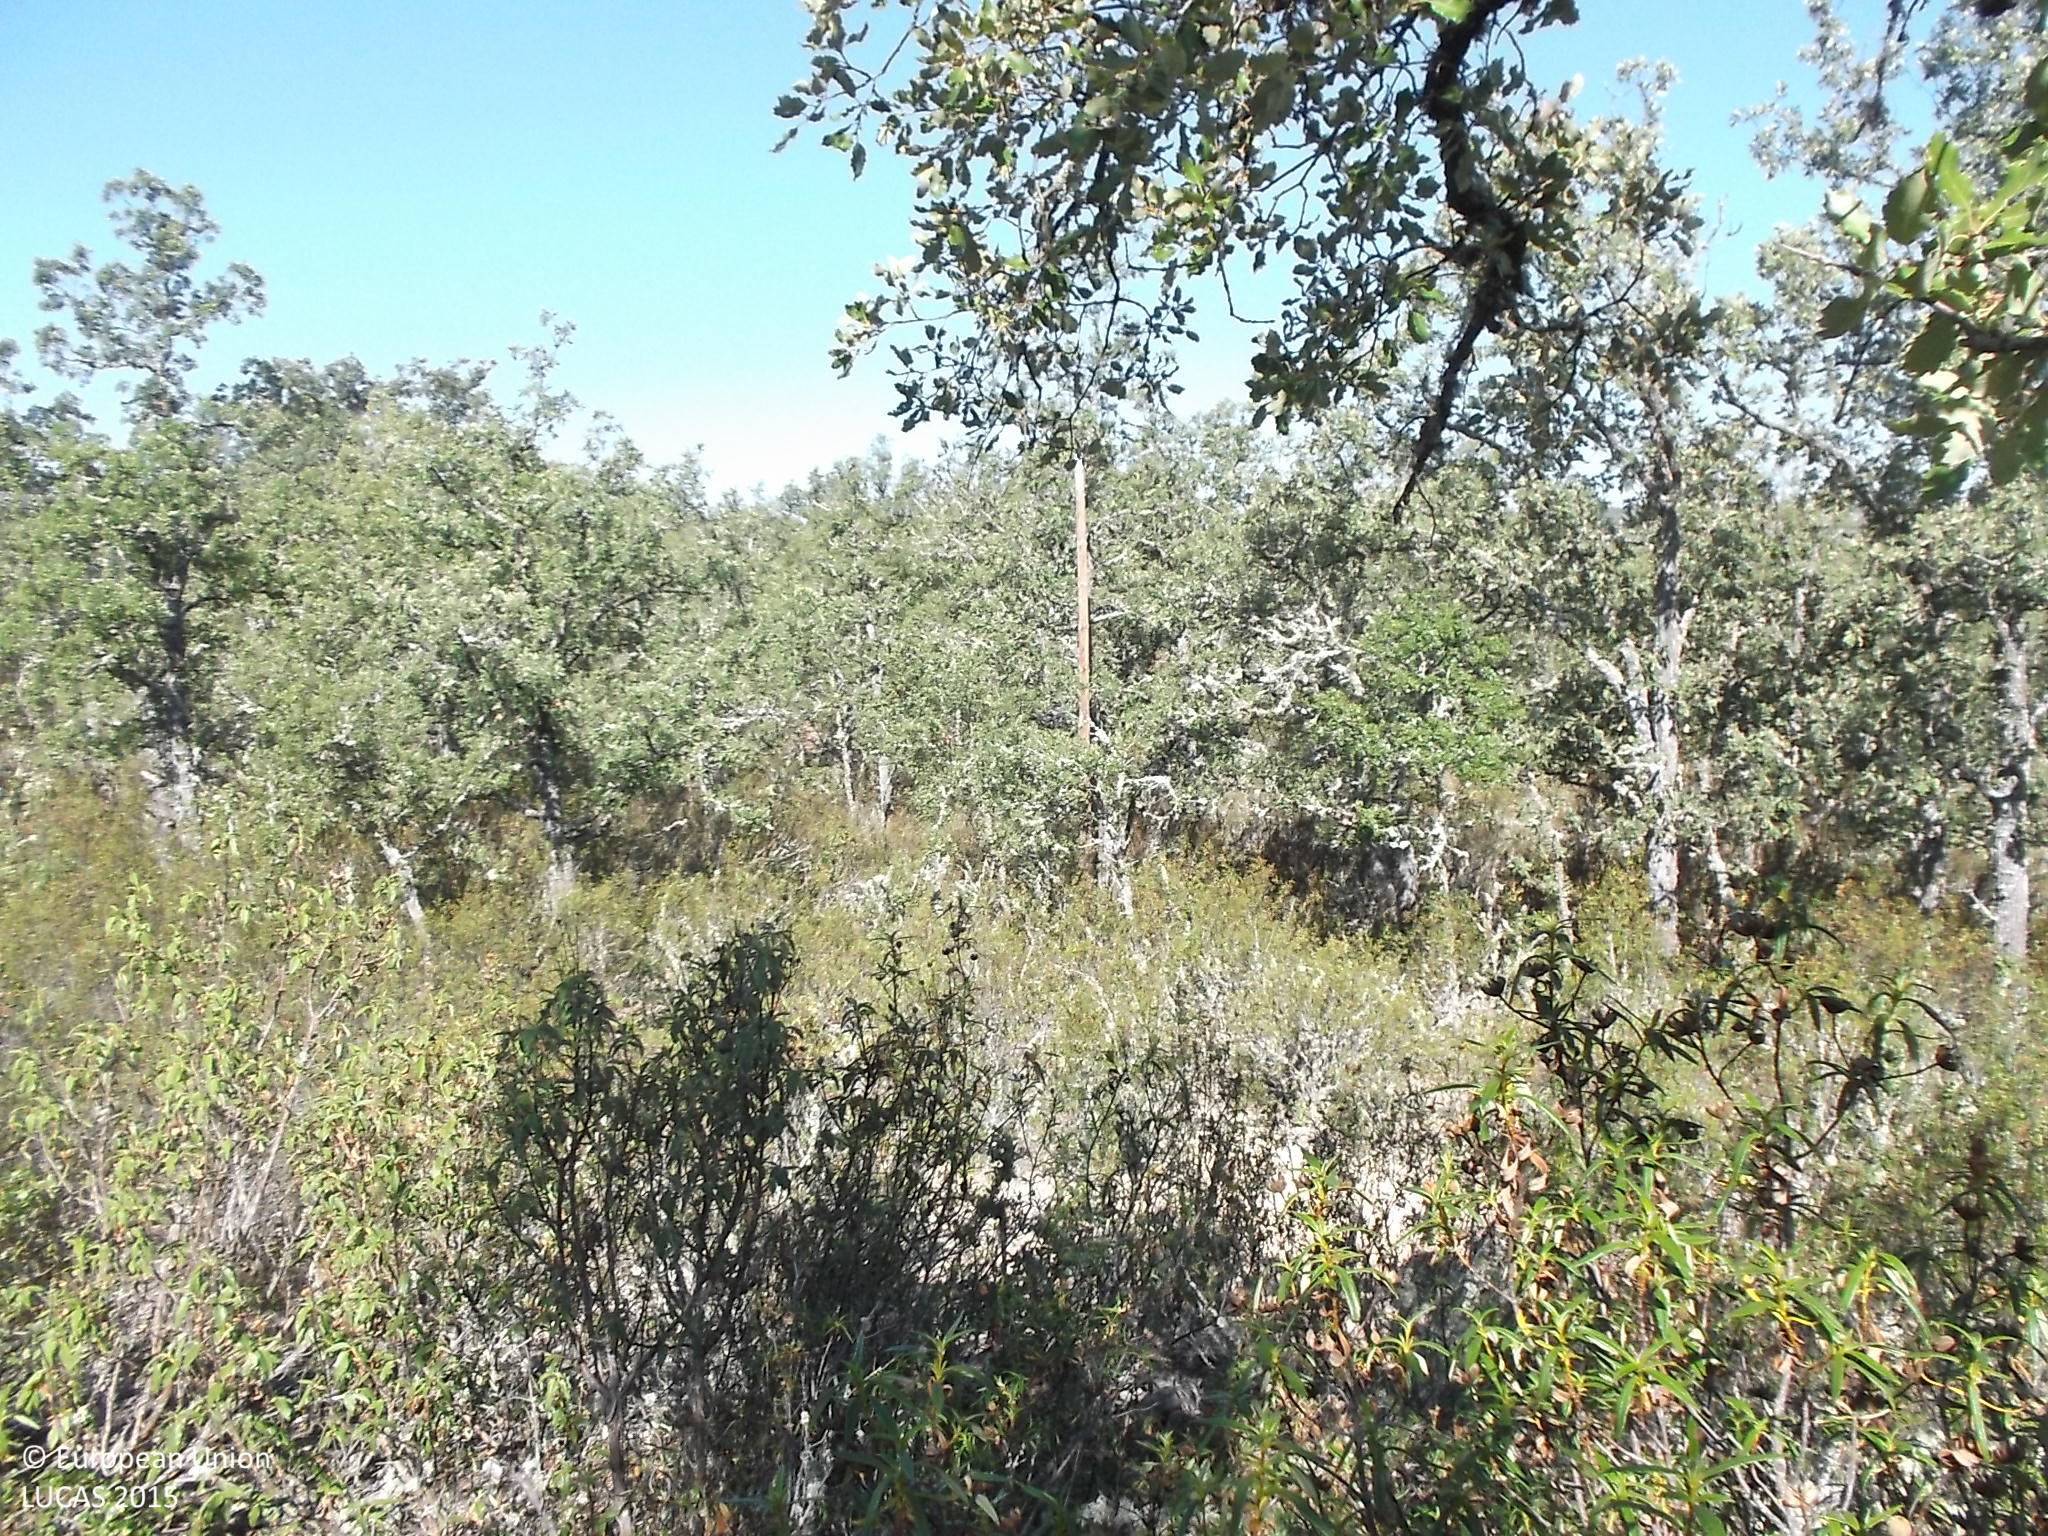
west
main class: Woodland
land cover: Broadleaved woodland
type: broadleaved evergreen forest
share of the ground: 10 - 25 %
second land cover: Shrubland without tree cover
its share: 50 - 75 %
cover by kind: shrubs 80 %, broadleaved forest trees 20 %
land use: Forestry
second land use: Agriculture (excluding fallow land and kitchen gardens)
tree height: < 5 m
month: July
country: ES
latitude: 41.2889
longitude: -5.8352
